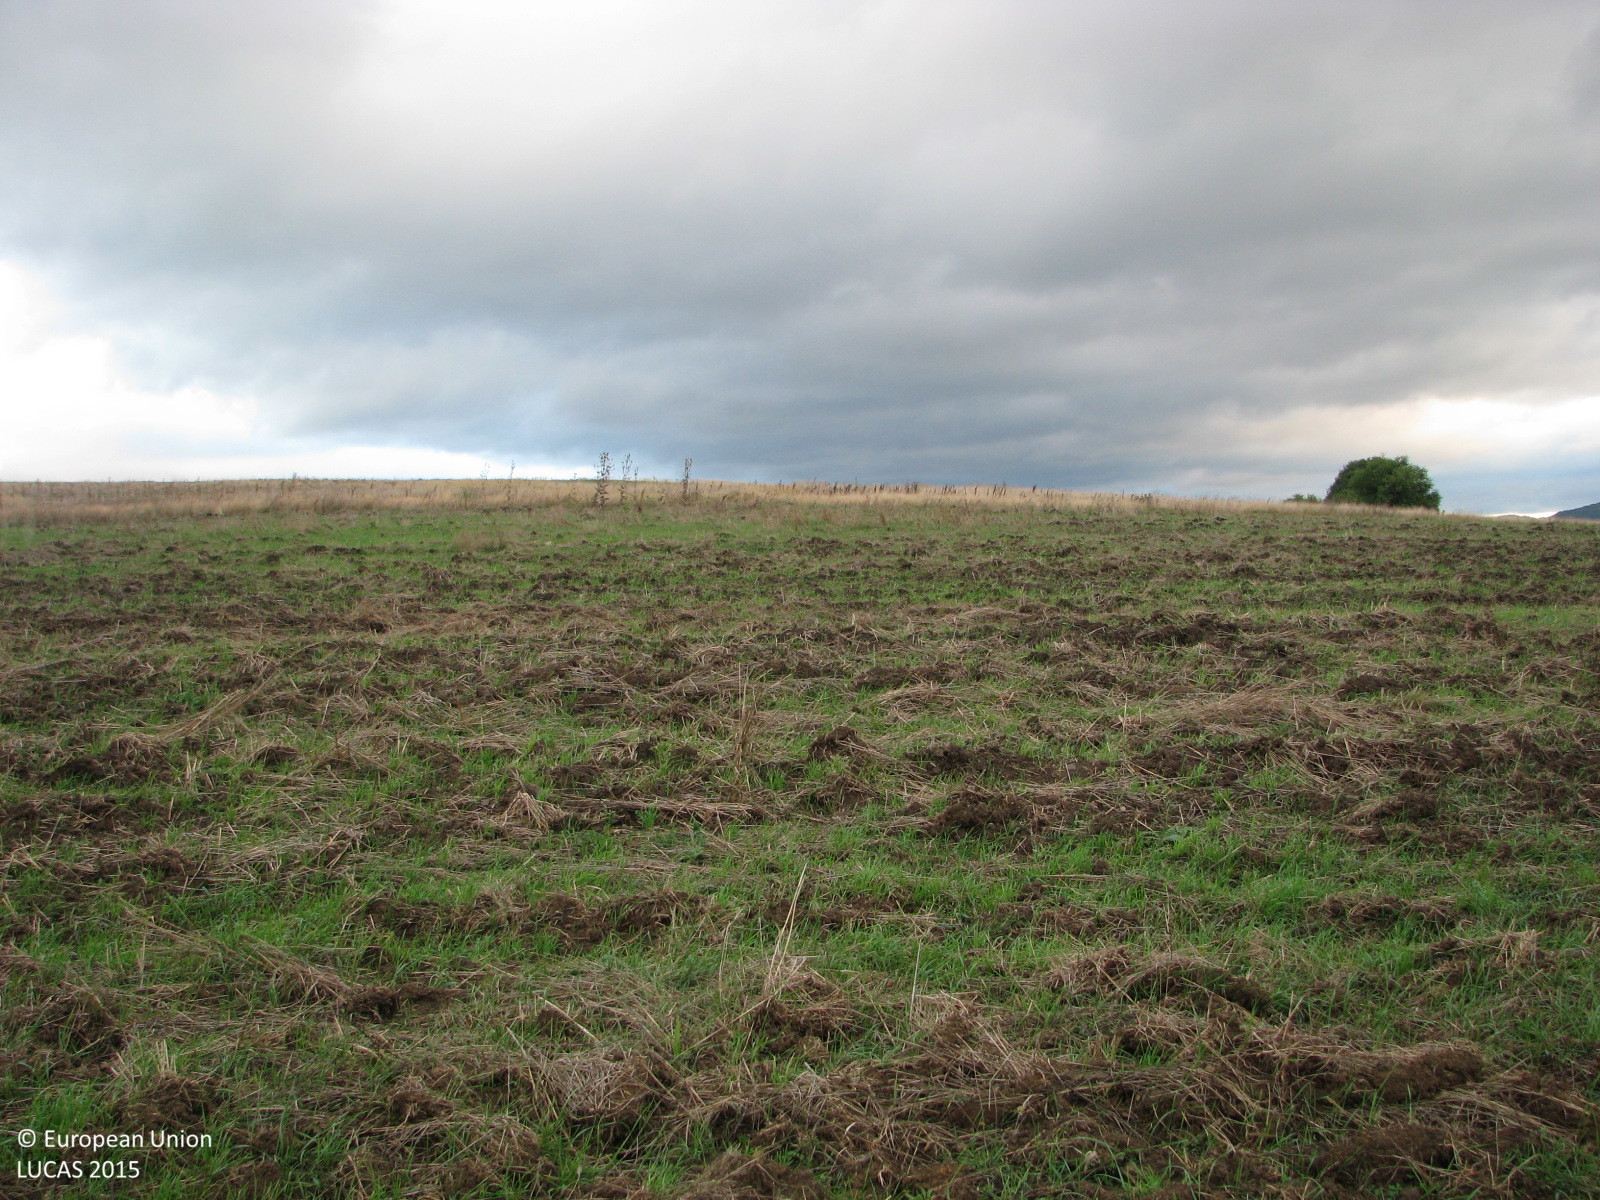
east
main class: Cropland
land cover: Common wheat
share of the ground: 10 - 25 %
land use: Agriculture (excluding fallow land and kitchen gardens)
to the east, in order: Common wheat; Grassland without tree/shrub cover; Tracks; Grassland without tree/shrub cover; Spontaneously vegetated surfaces; Grassland without tree/shrub cover
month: September
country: BG
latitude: 42.8052
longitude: 26.3437
